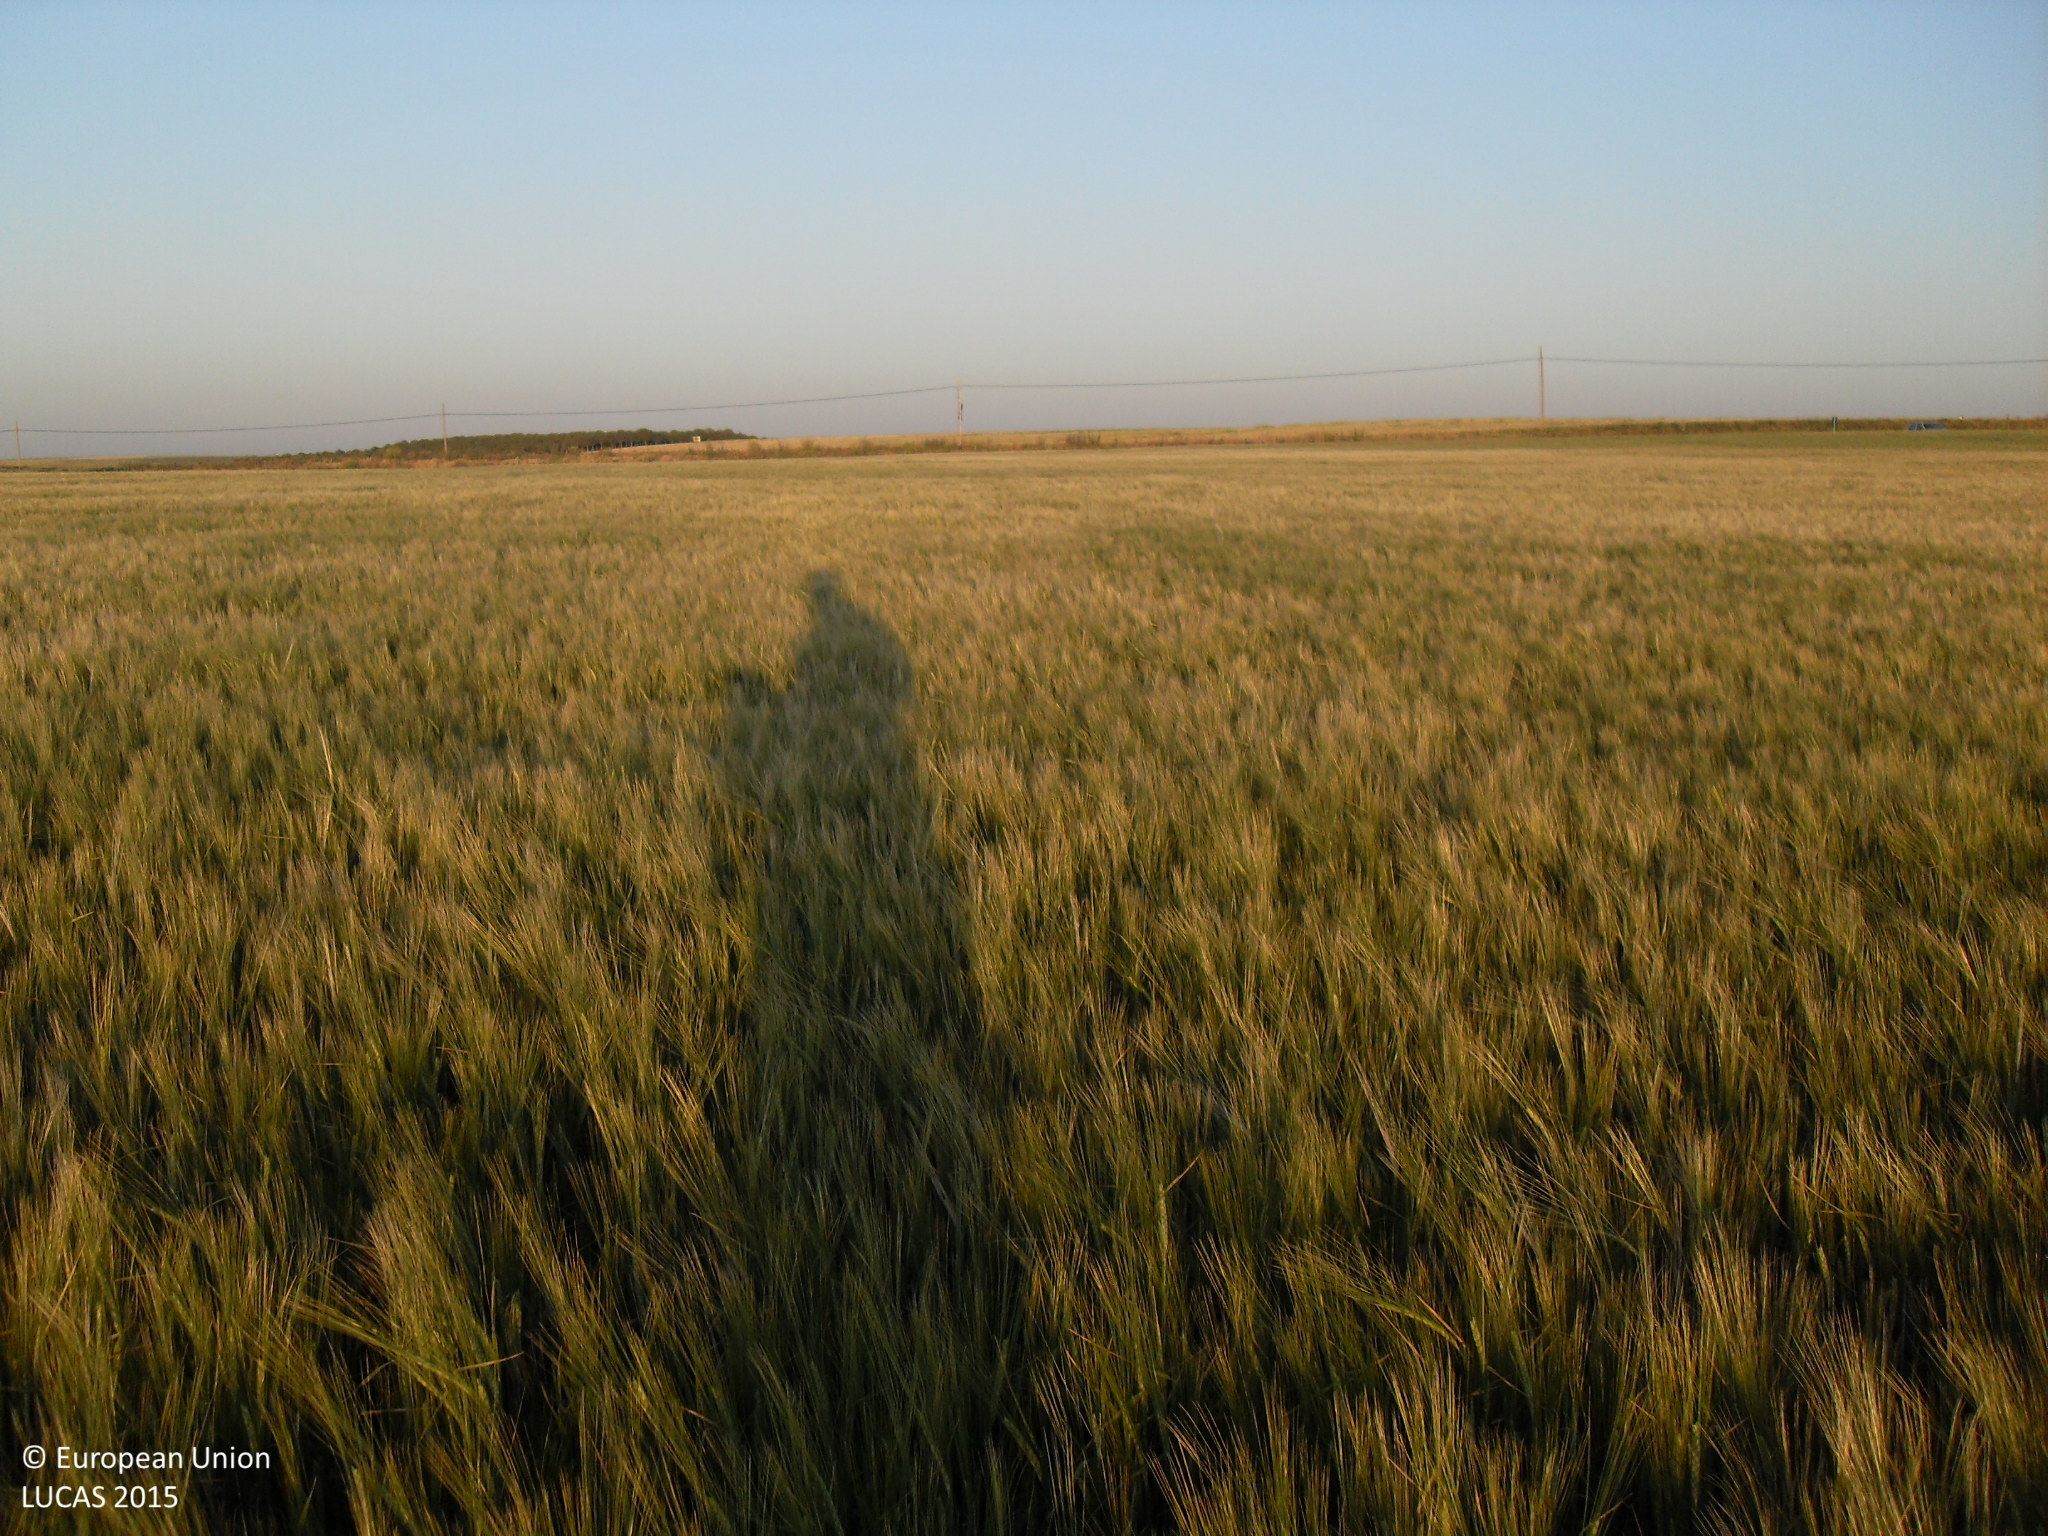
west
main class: Cropland
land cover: Barley
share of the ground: > 75 %
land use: Agriculture (excluding fallow land and kitchen gardens)
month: May
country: ES
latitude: 41.0420
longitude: -5.1892
